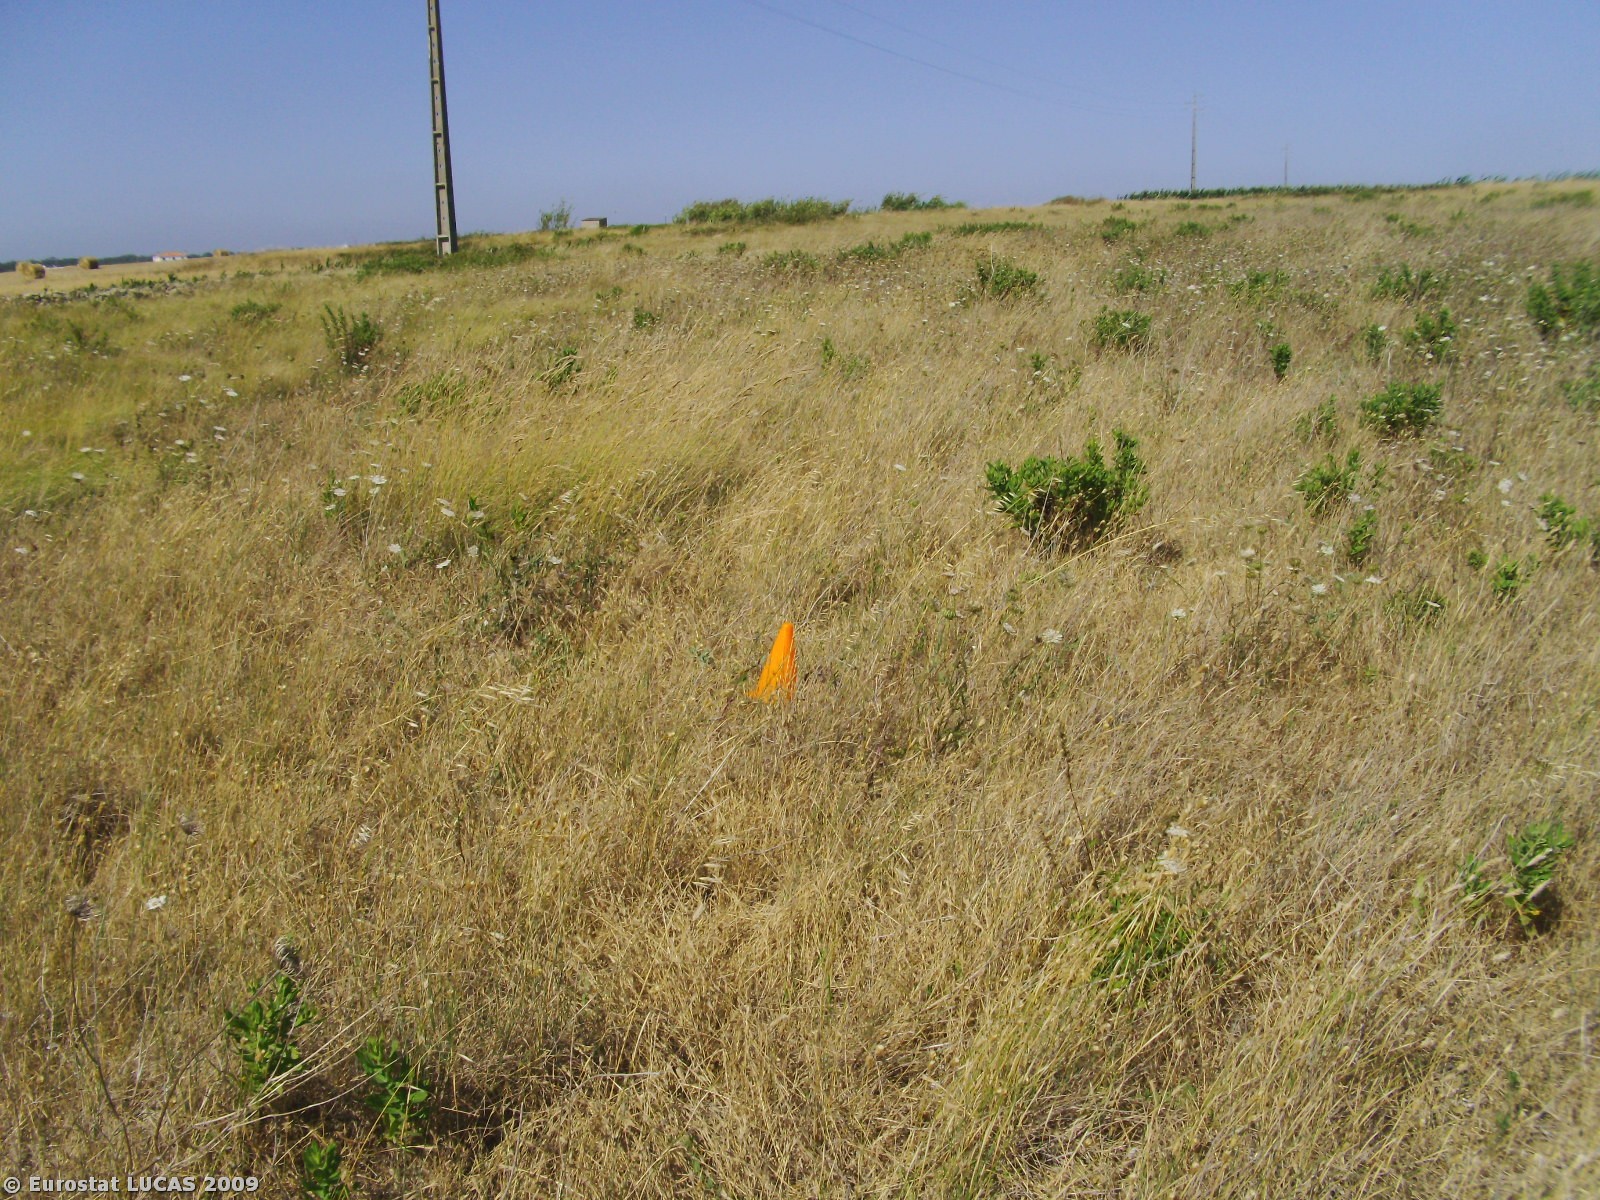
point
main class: Grassland
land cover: Spontaneously vegetated surfaces
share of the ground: > 75 %
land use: Fallow land
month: July
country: PT
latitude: 38.8984
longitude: -9.4234
